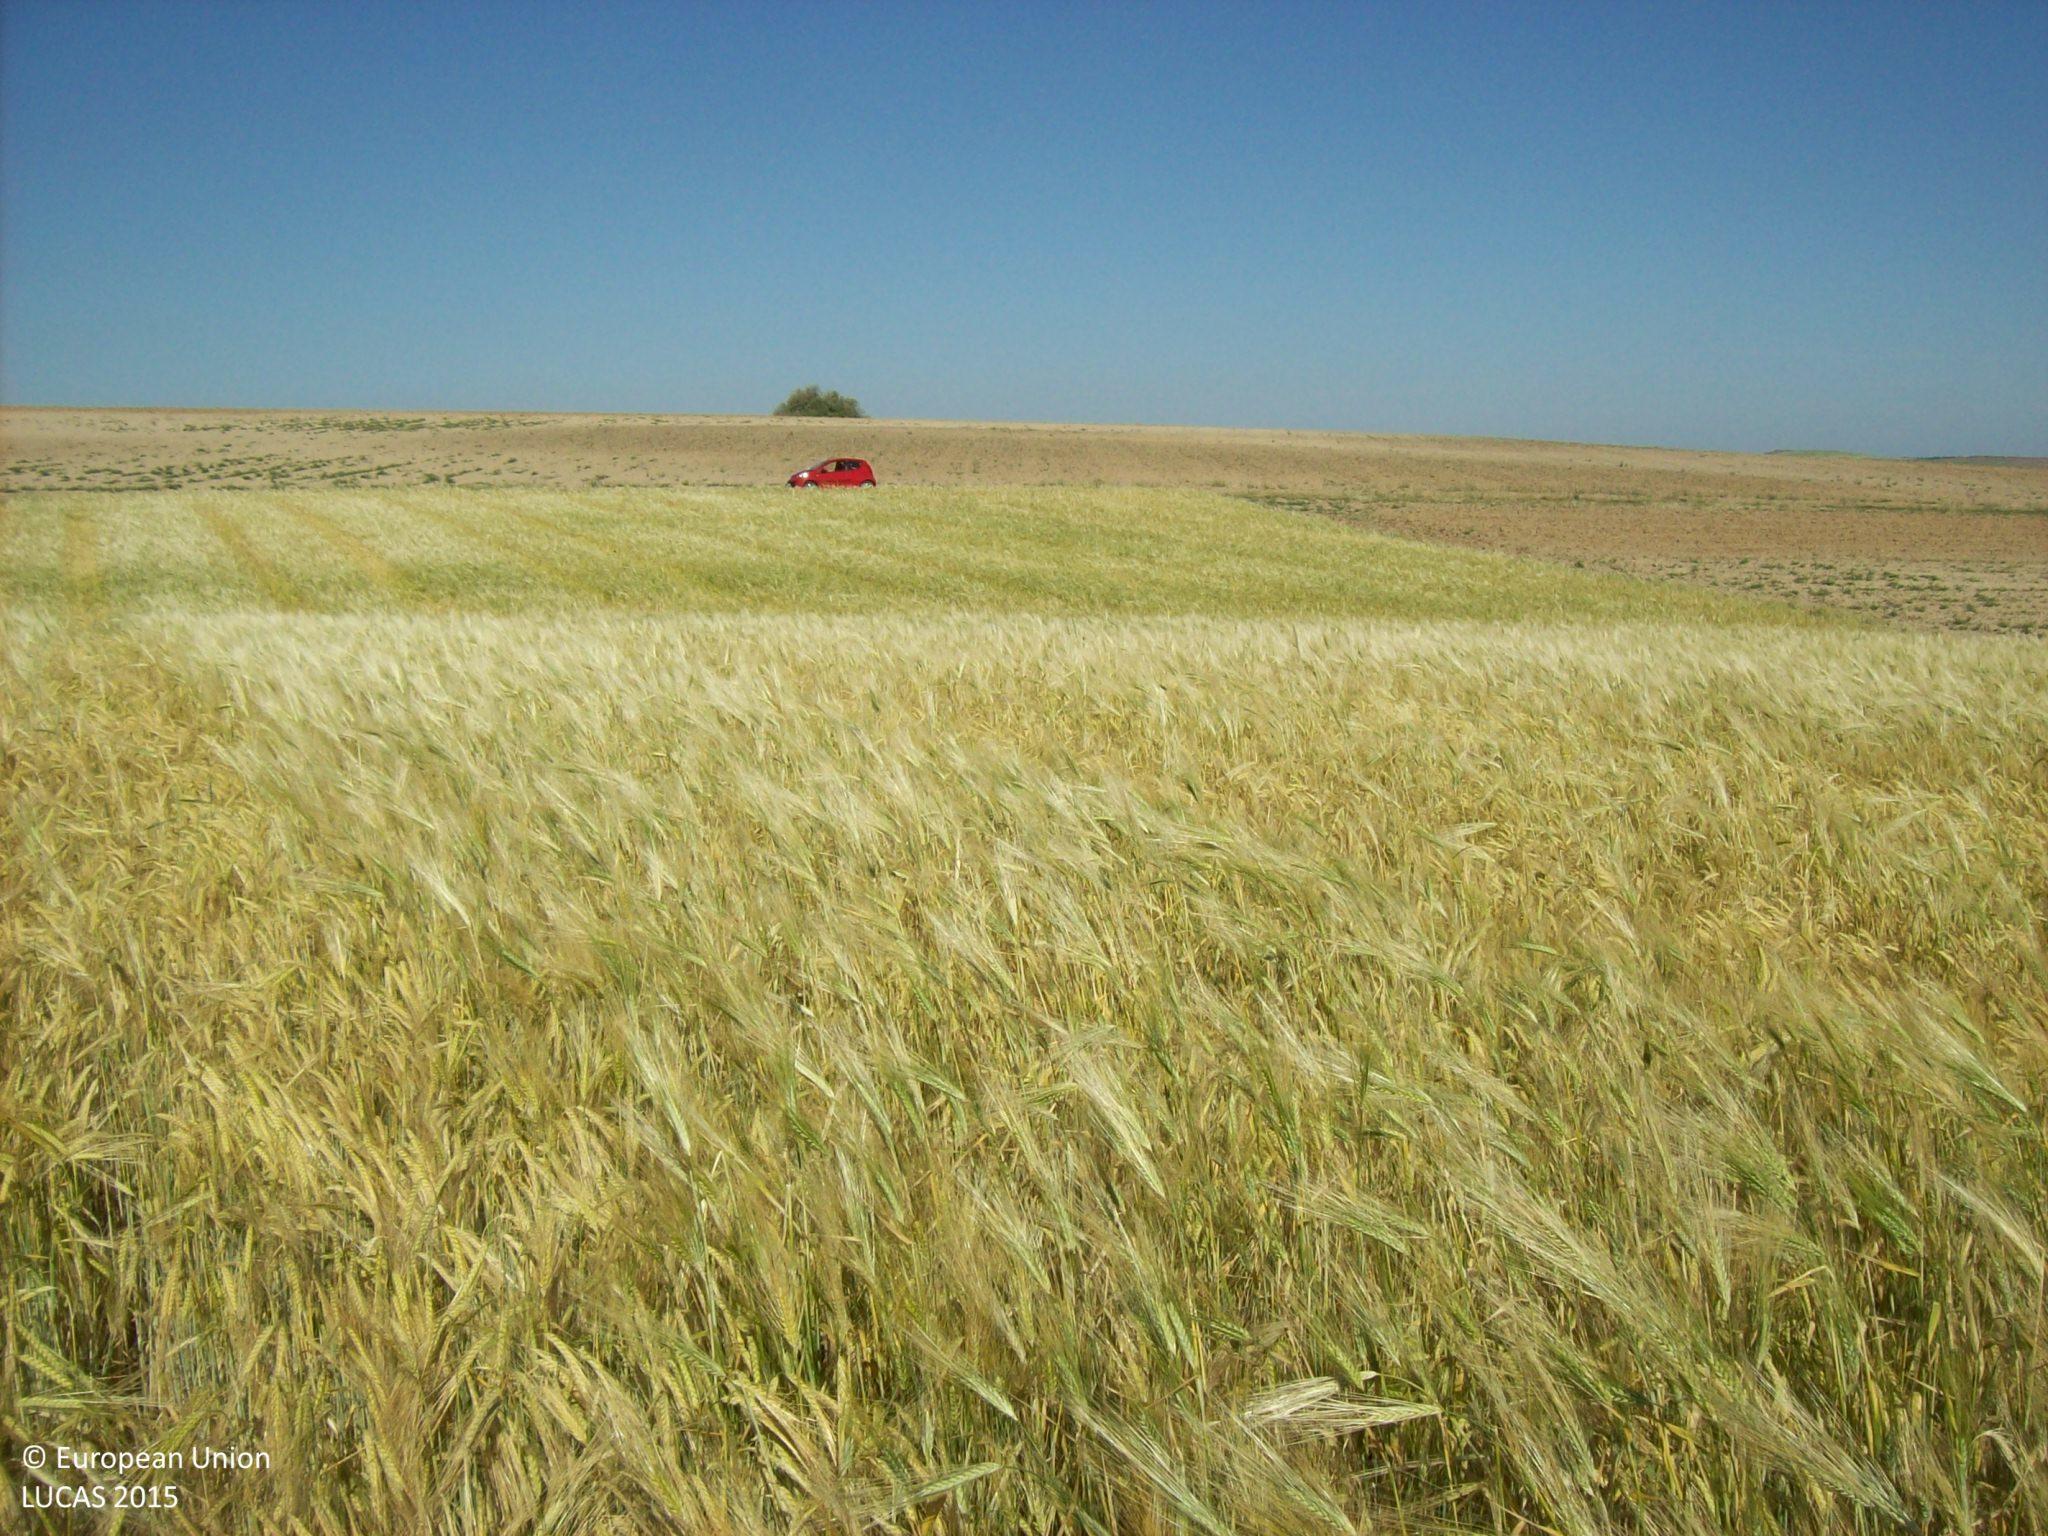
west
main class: Cropland
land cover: Barley
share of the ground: > 75 %
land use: Agriculture (excluding fallow land and kitchen gardens)
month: May
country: ES
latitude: 40.9782
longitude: -4.5205
